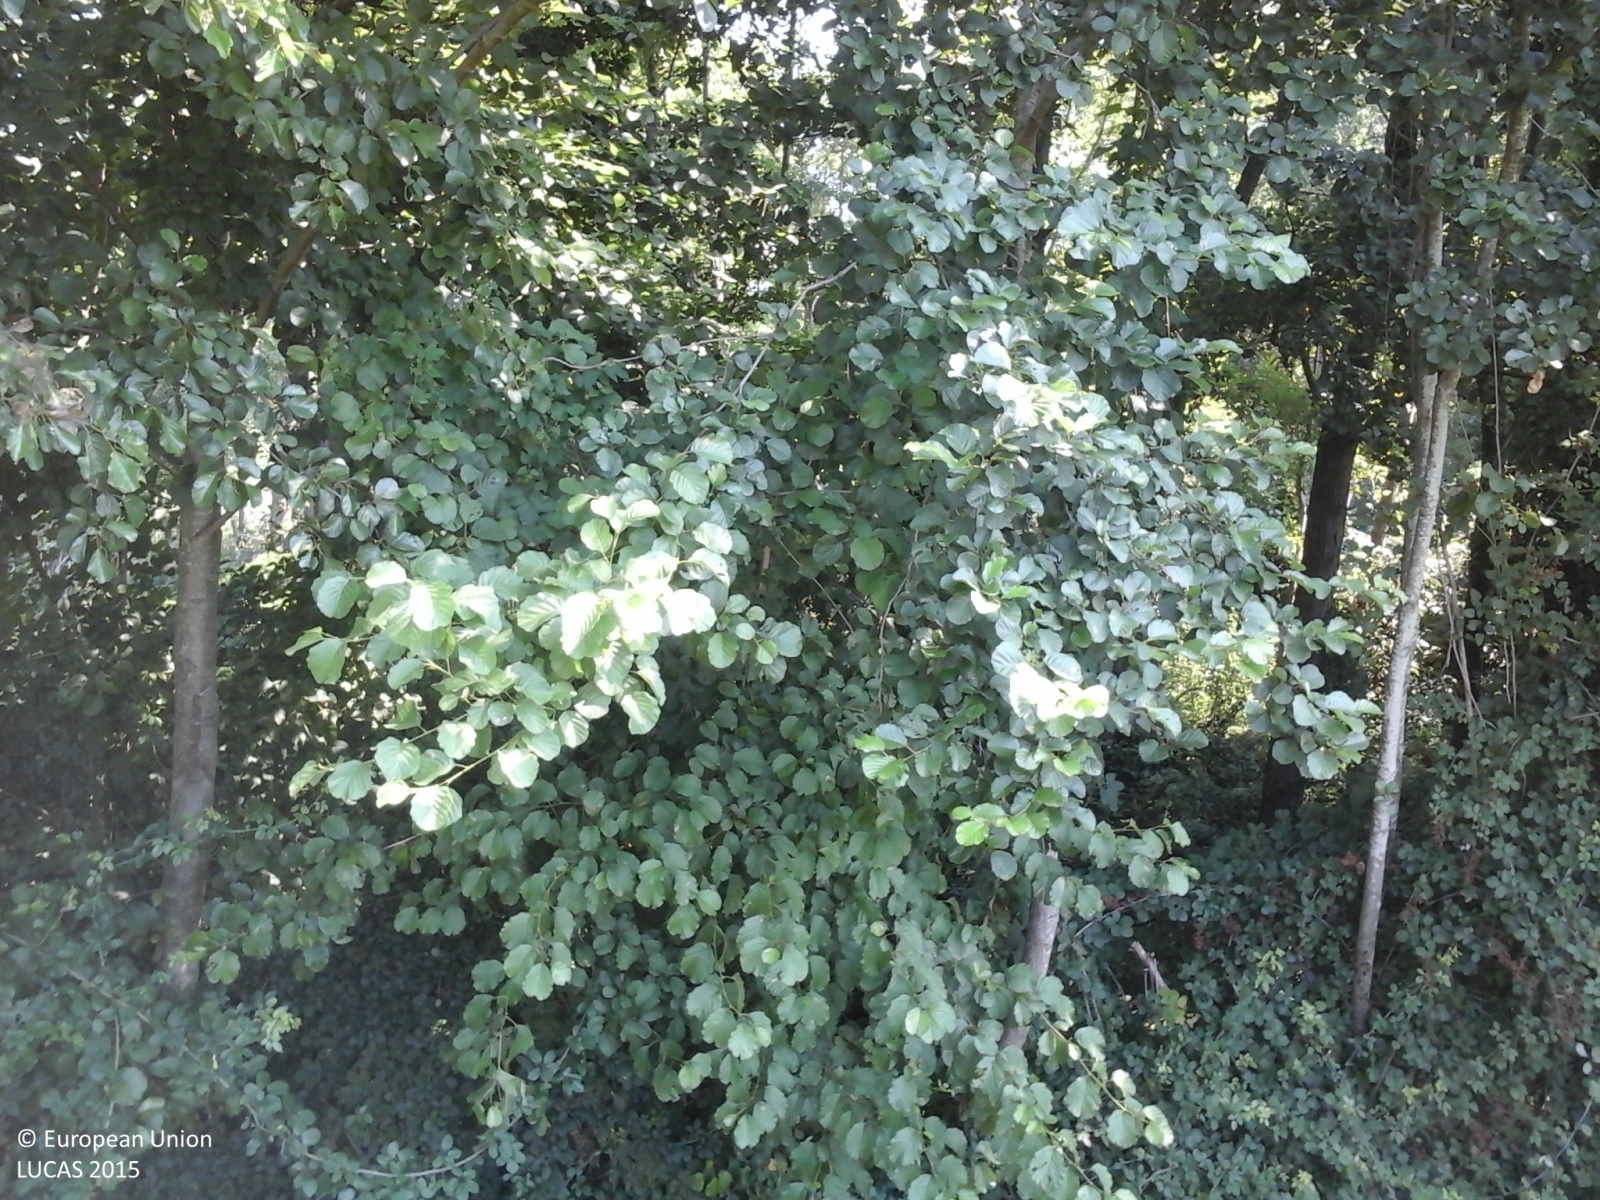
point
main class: Woodland
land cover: Broadleaved woodland
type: thermophilous deciduous forest
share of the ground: > 75 %
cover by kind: broadleaved forest trees 100 %
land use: Semi-natural and natural areas not in use
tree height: > 5 m
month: August
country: IT
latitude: 43.9896
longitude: 10.1617
